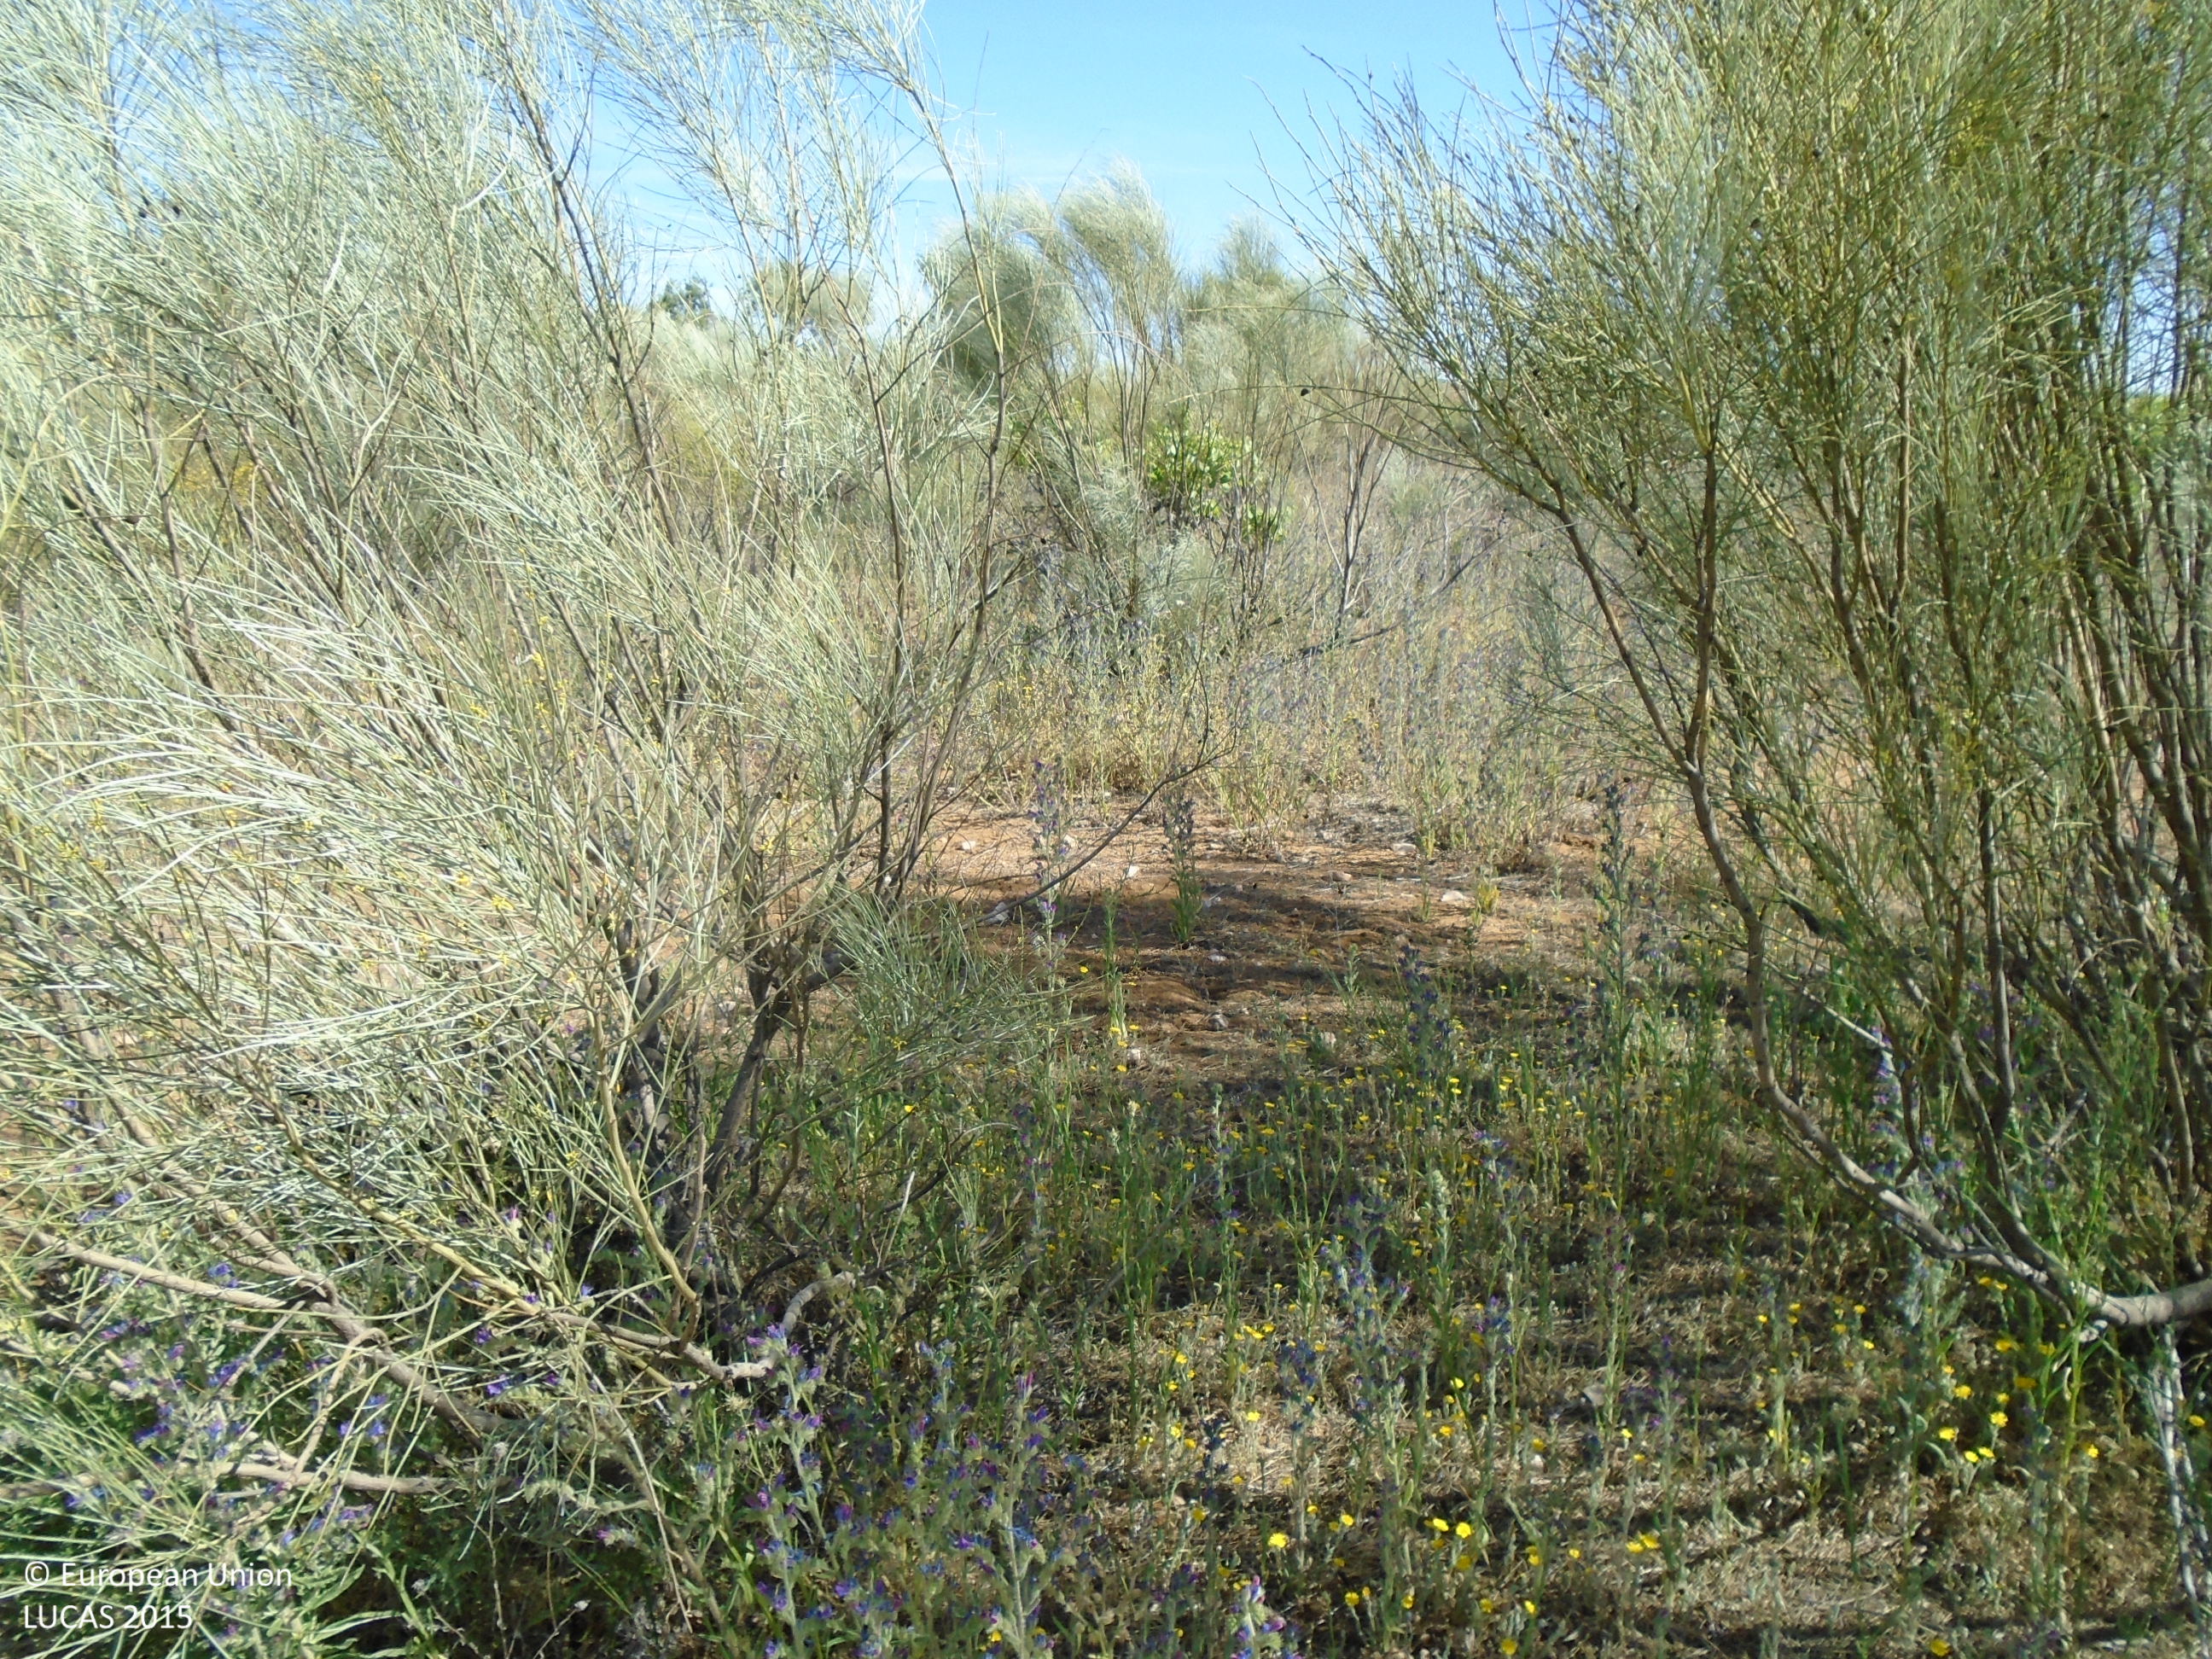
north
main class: Cropland
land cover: Vineyards
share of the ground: 10 - 25 %
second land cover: Shrubland without tree cover
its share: 25 - 50 %
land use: Abandoned areas
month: May
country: ES
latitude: 39.7743
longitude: -3.7239
